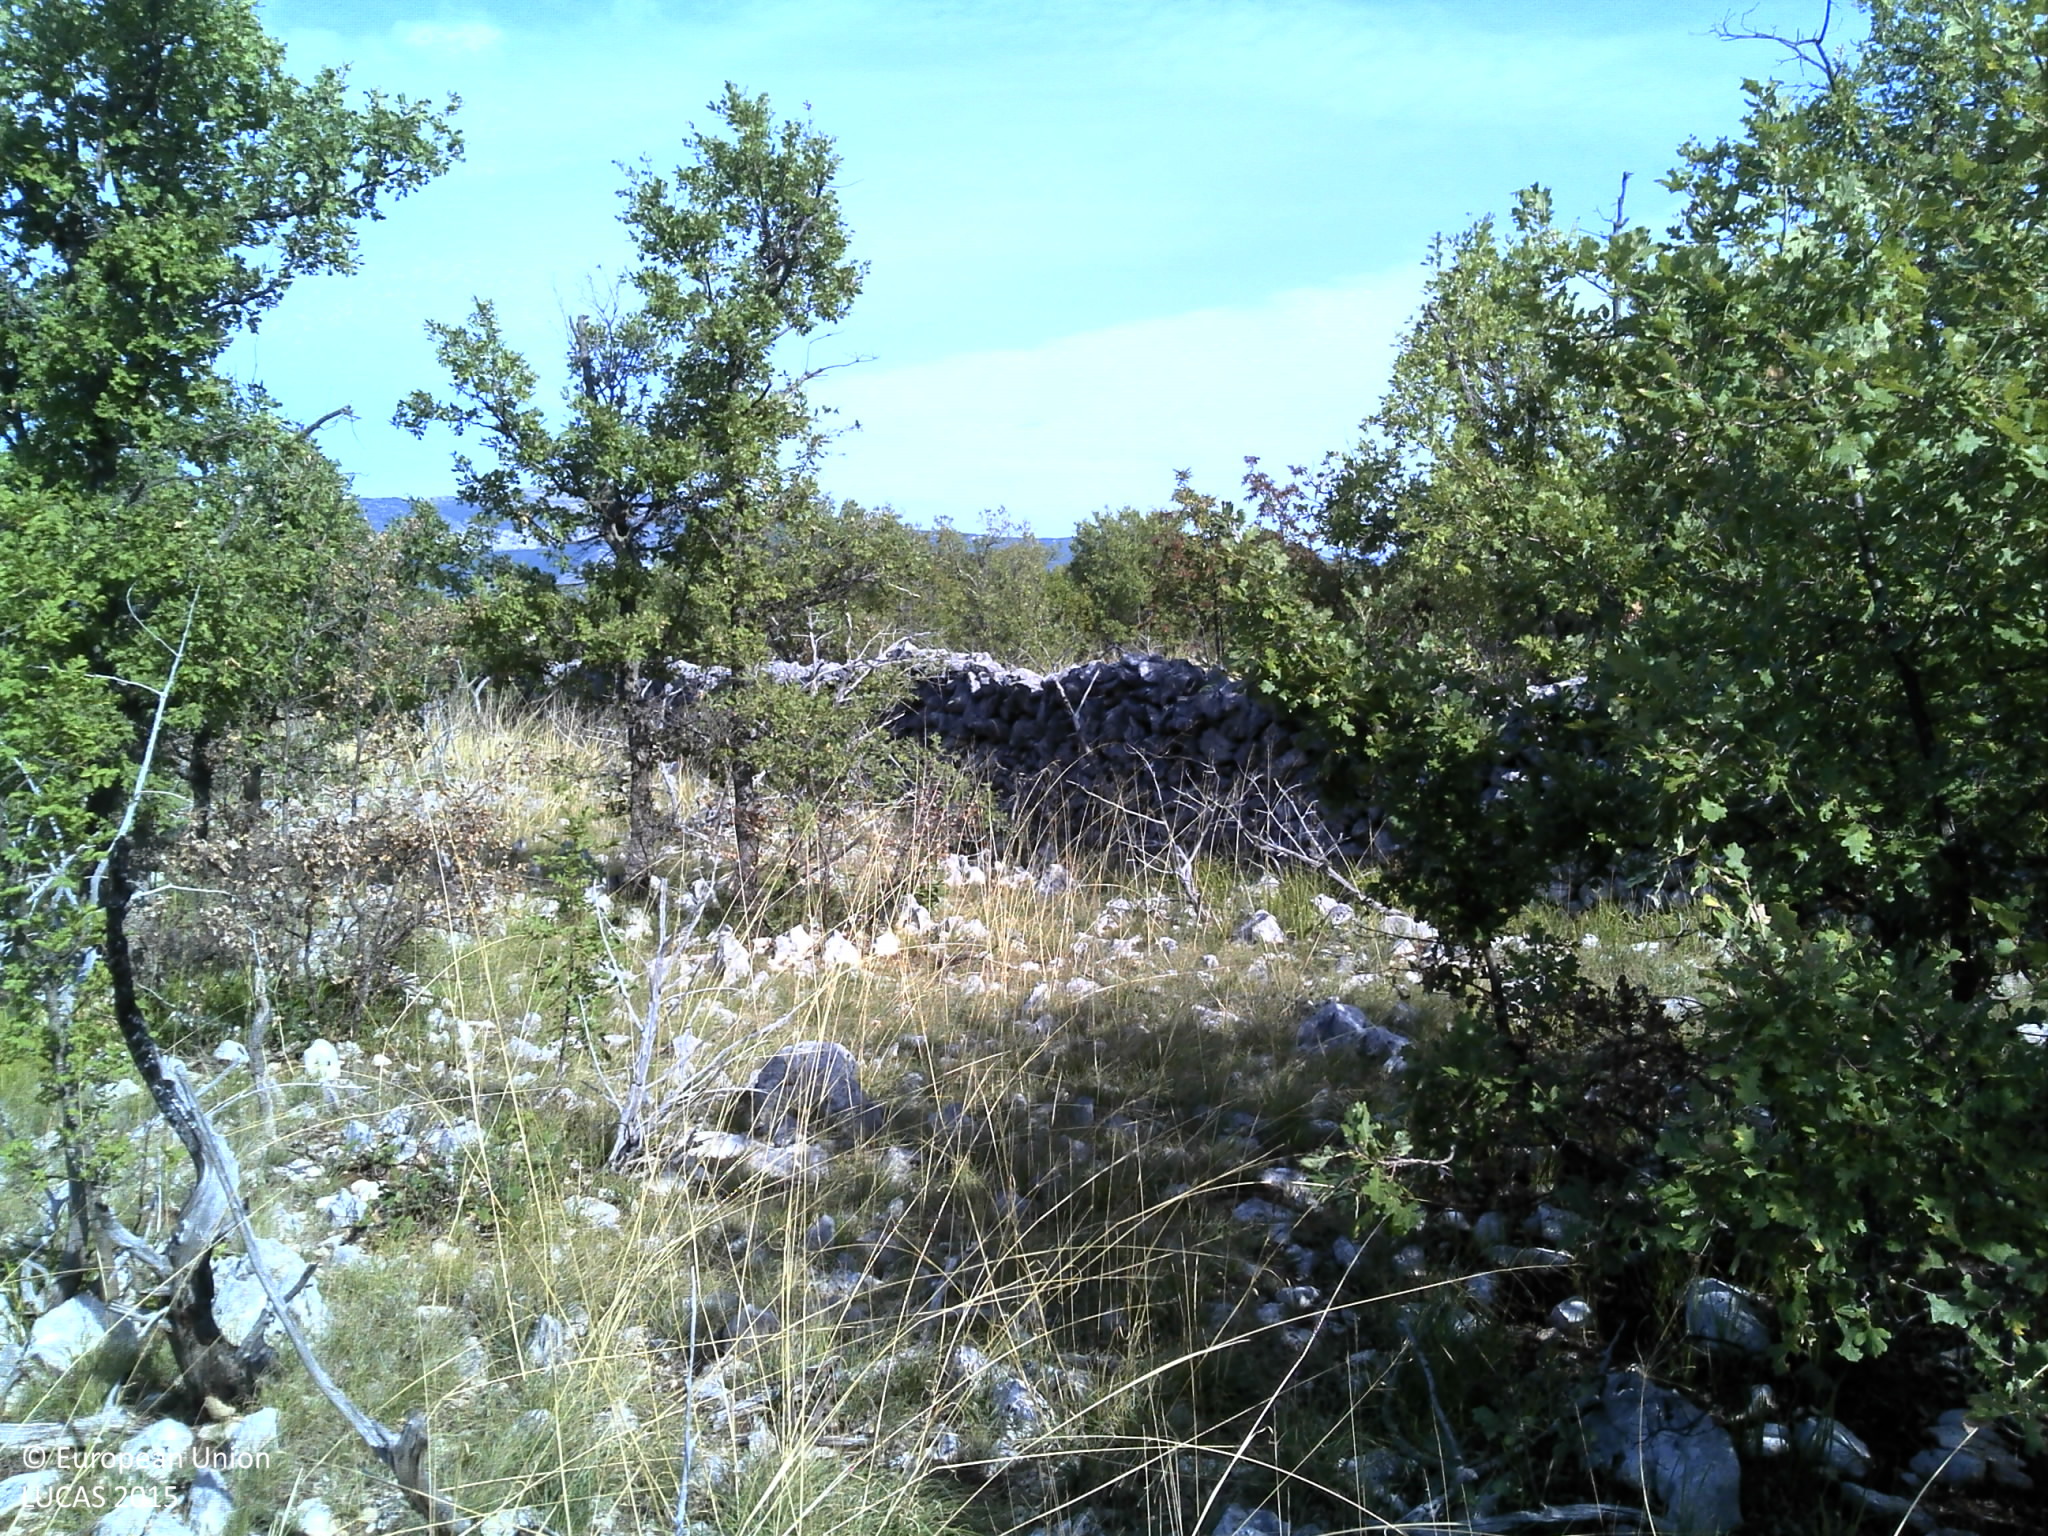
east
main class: Woodland
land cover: Broadleaved woodland
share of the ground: 25 - 50 %
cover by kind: herbaceous plants 35 %, broadleaved forest trees 30 %, consolidated bare surface 20 %, shrubs 15 %
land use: Abandoned areas
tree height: < 5 m
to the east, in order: Broadleaved woodland; Grassland with sparse tree/shrub cover; Dry stone walls; Shrubland with sparse tree cover; Dry stone walls; Shrubland with sparse tree cover; Dry stone walls; Shrubland with sparse tree cover; Dry stone walls; Shrubland with sparse tree cover; Dry stone walls; Broadleaved woodland; Dry stone walls; Shrubland with sparse tree cover; Dry stone walls; Broadleaved woodland; Grassland with sparse tree/shrub cover
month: September
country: HR
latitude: 43.9219
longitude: 16.0323
